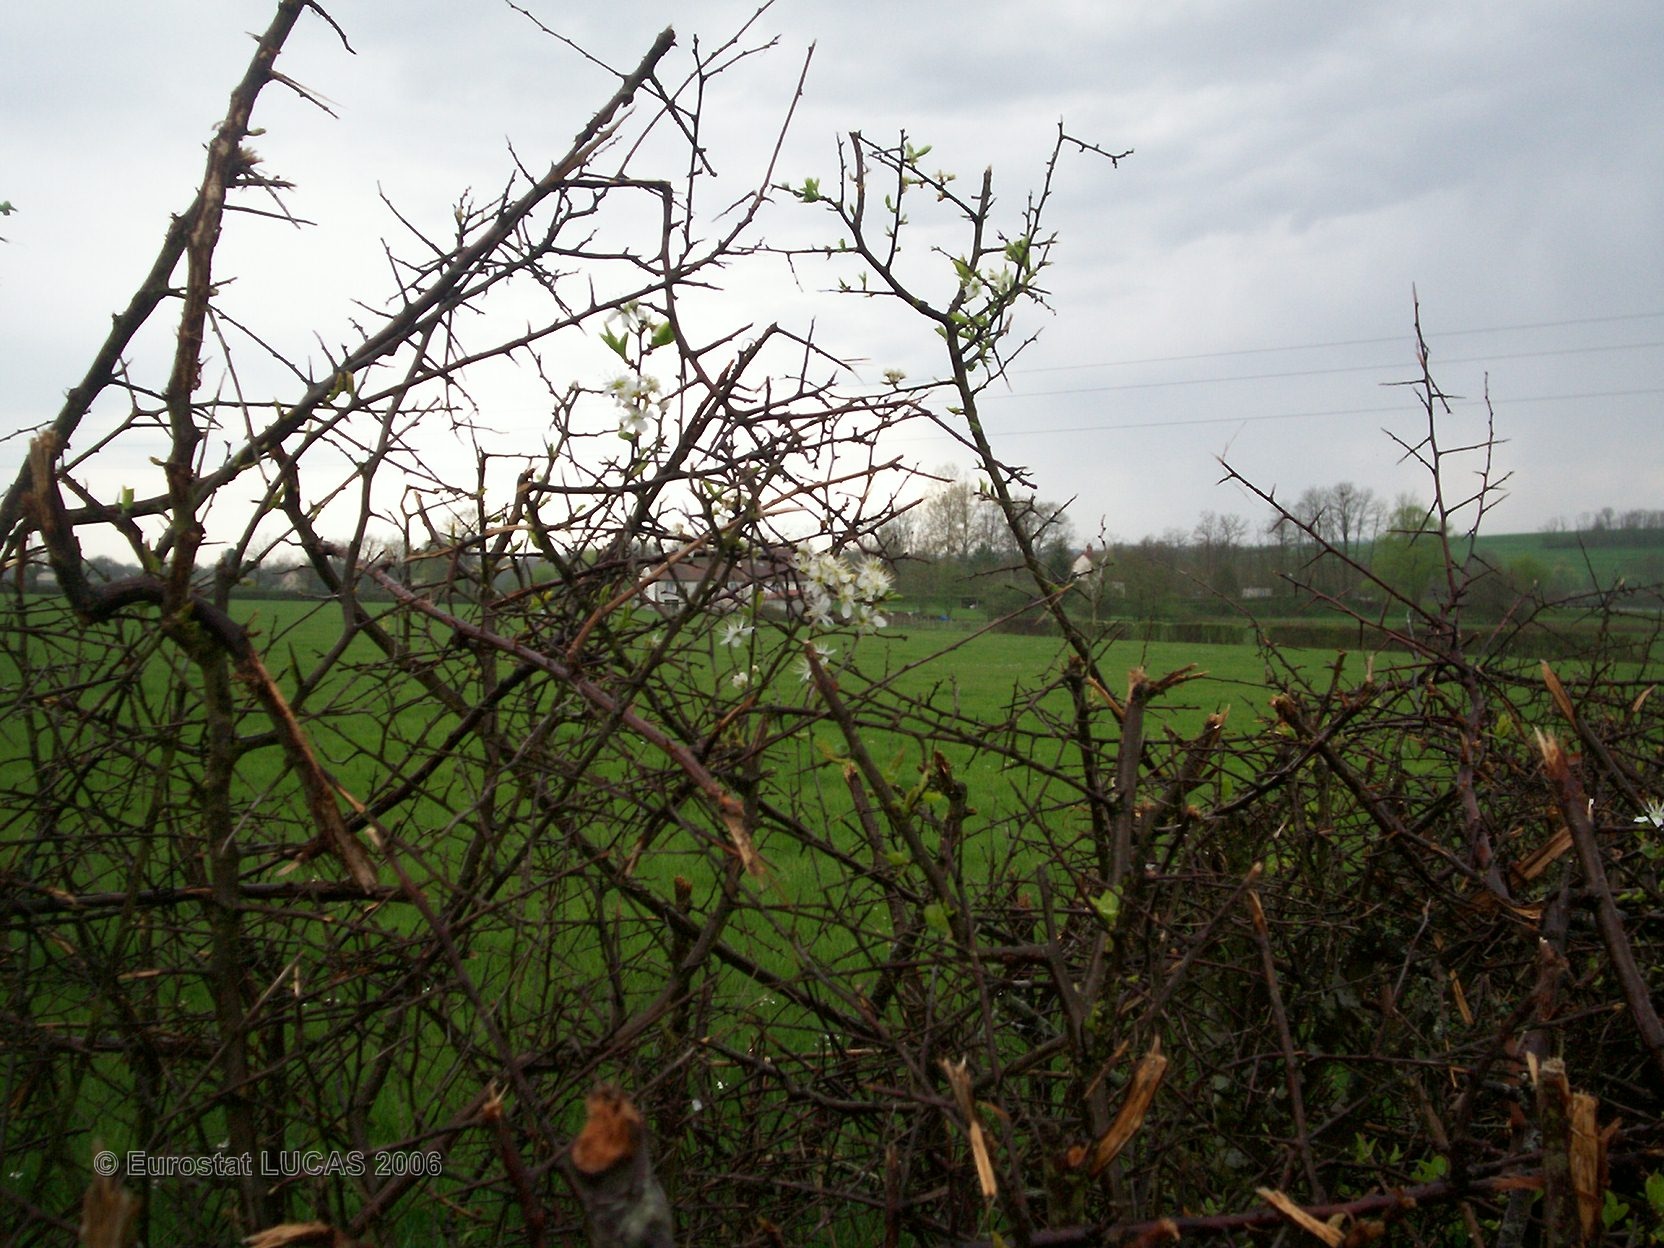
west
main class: Grassland
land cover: Grassland without tree/shrub cover
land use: Agriculture (excluding fallow land and kitchen gardens)
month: April
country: FR
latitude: 46.8291
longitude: 4.6128
